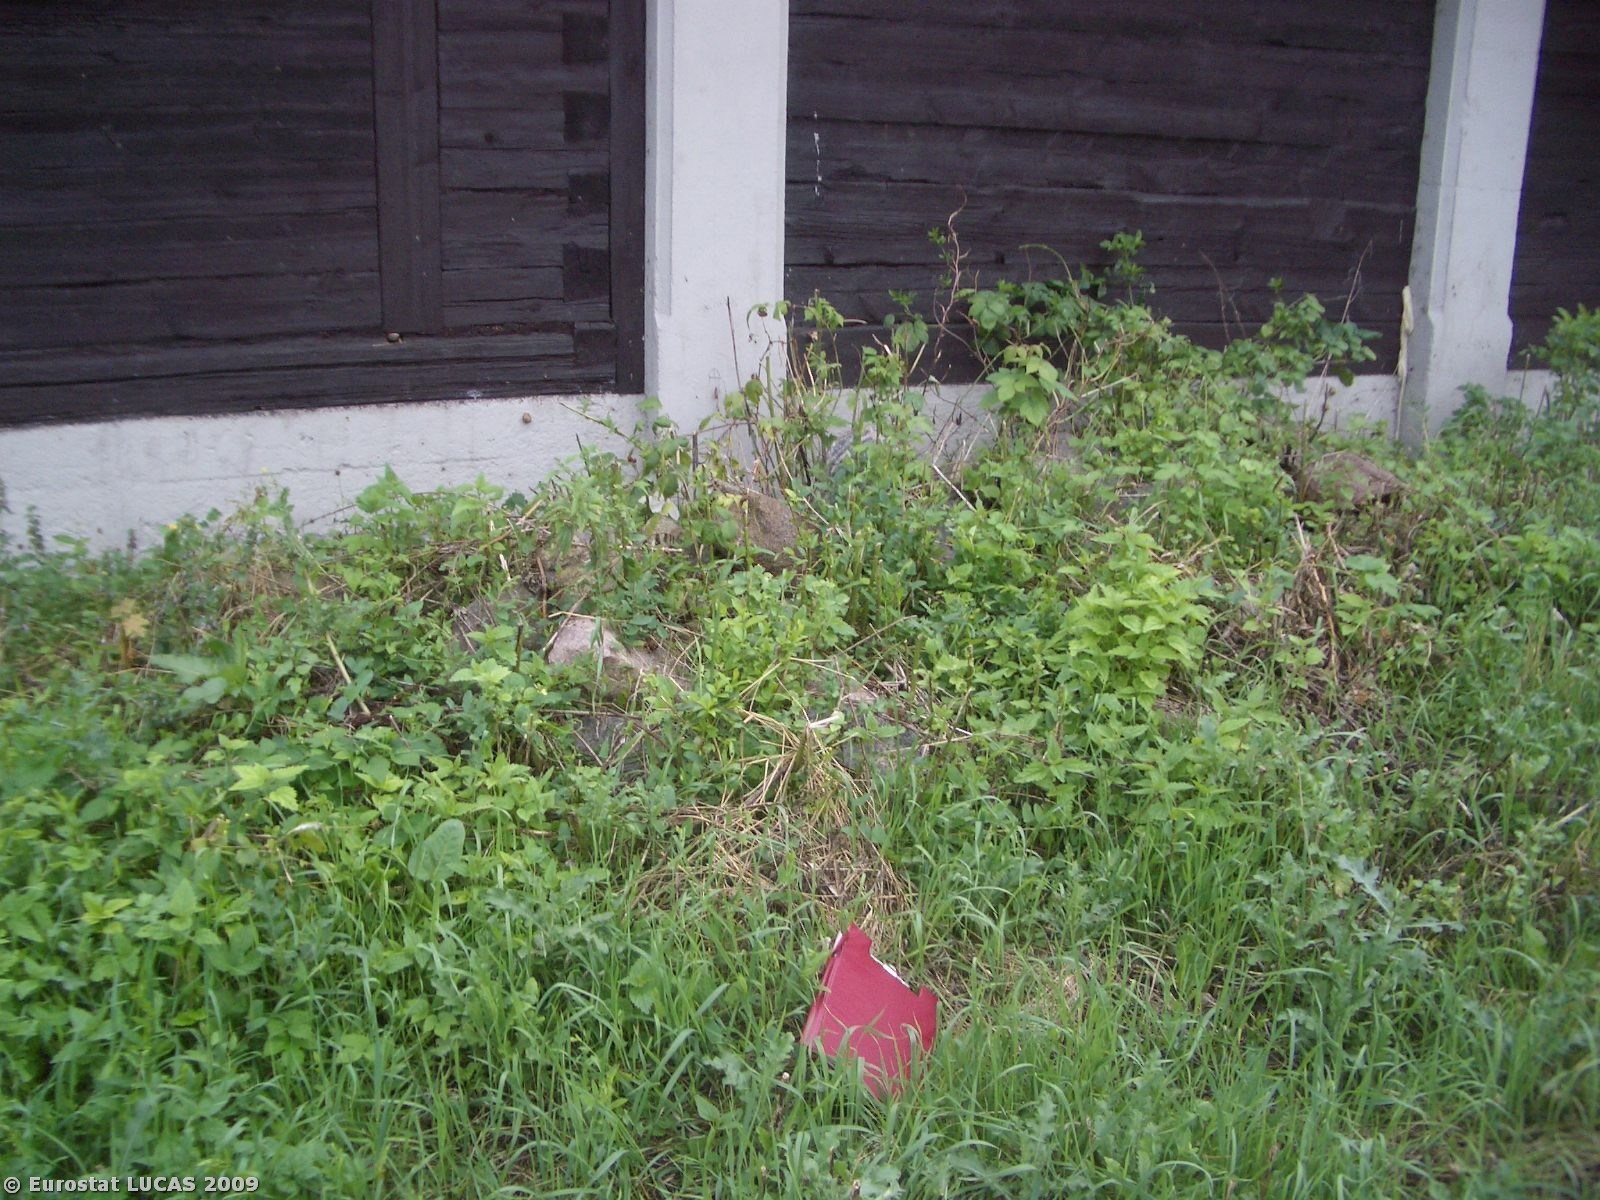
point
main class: Grassland
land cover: Grassland without tree/shrub cover
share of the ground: > 75 %
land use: Residential
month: August
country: PL
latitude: 53.1116
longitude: 23.2100
